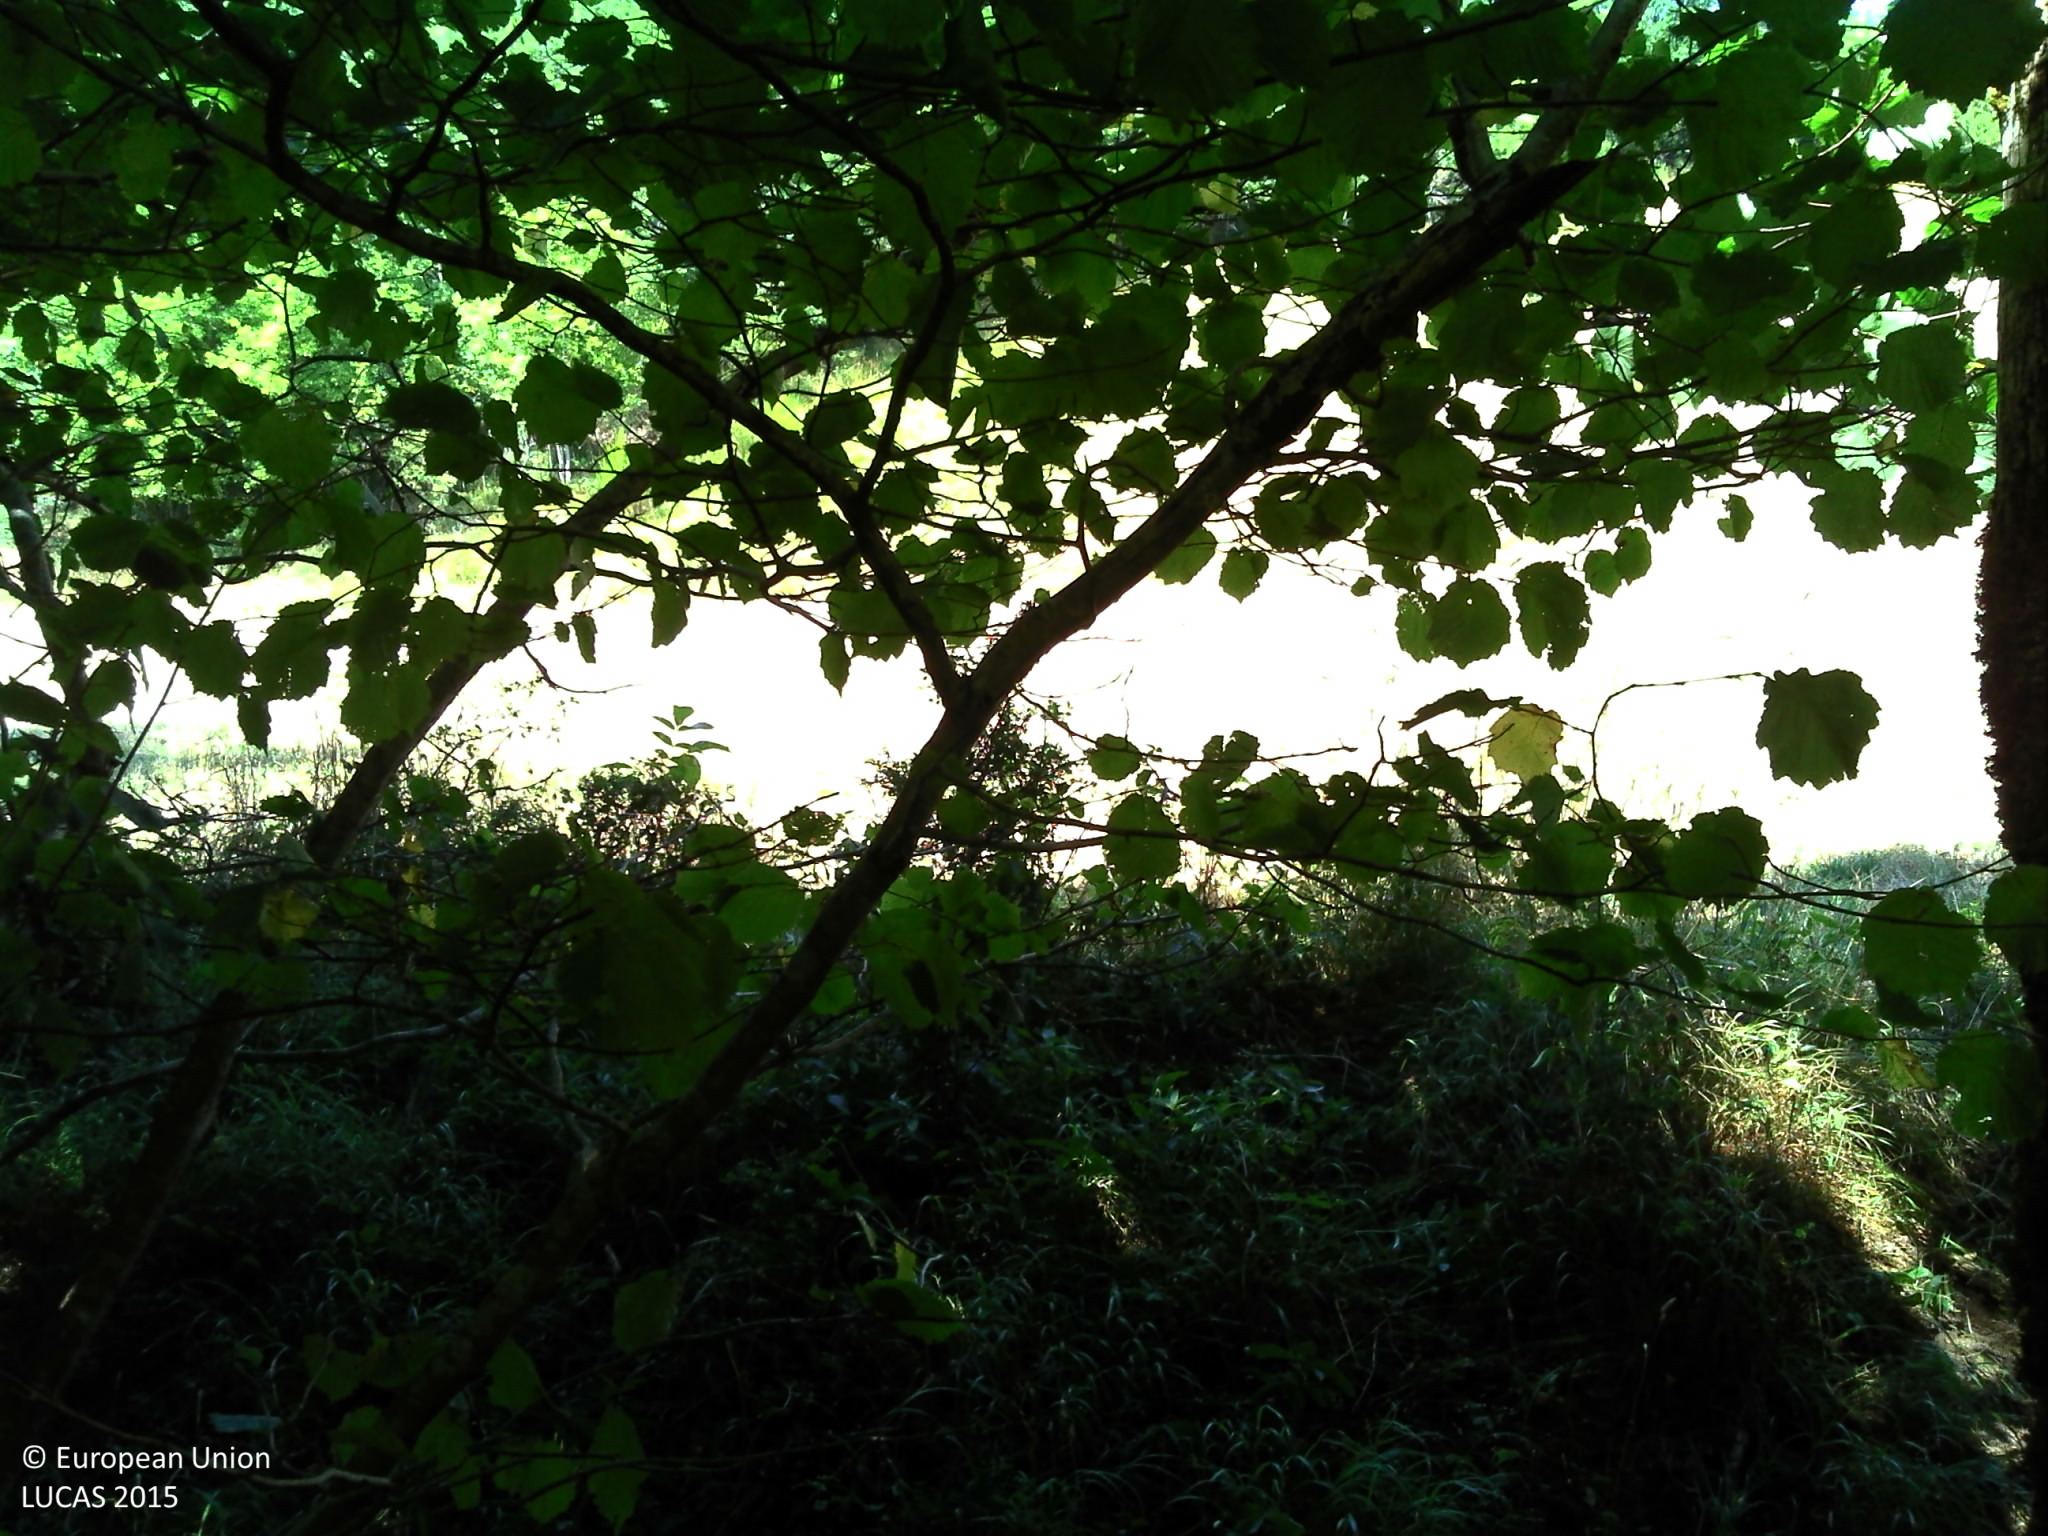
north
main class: Cropland
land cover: Temporary grasslands
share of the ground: > 75 %
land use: Agriculture (excluding fallow land and kitchen gardens)
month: August
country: FR
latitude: 43.7188
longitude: 3.0441
